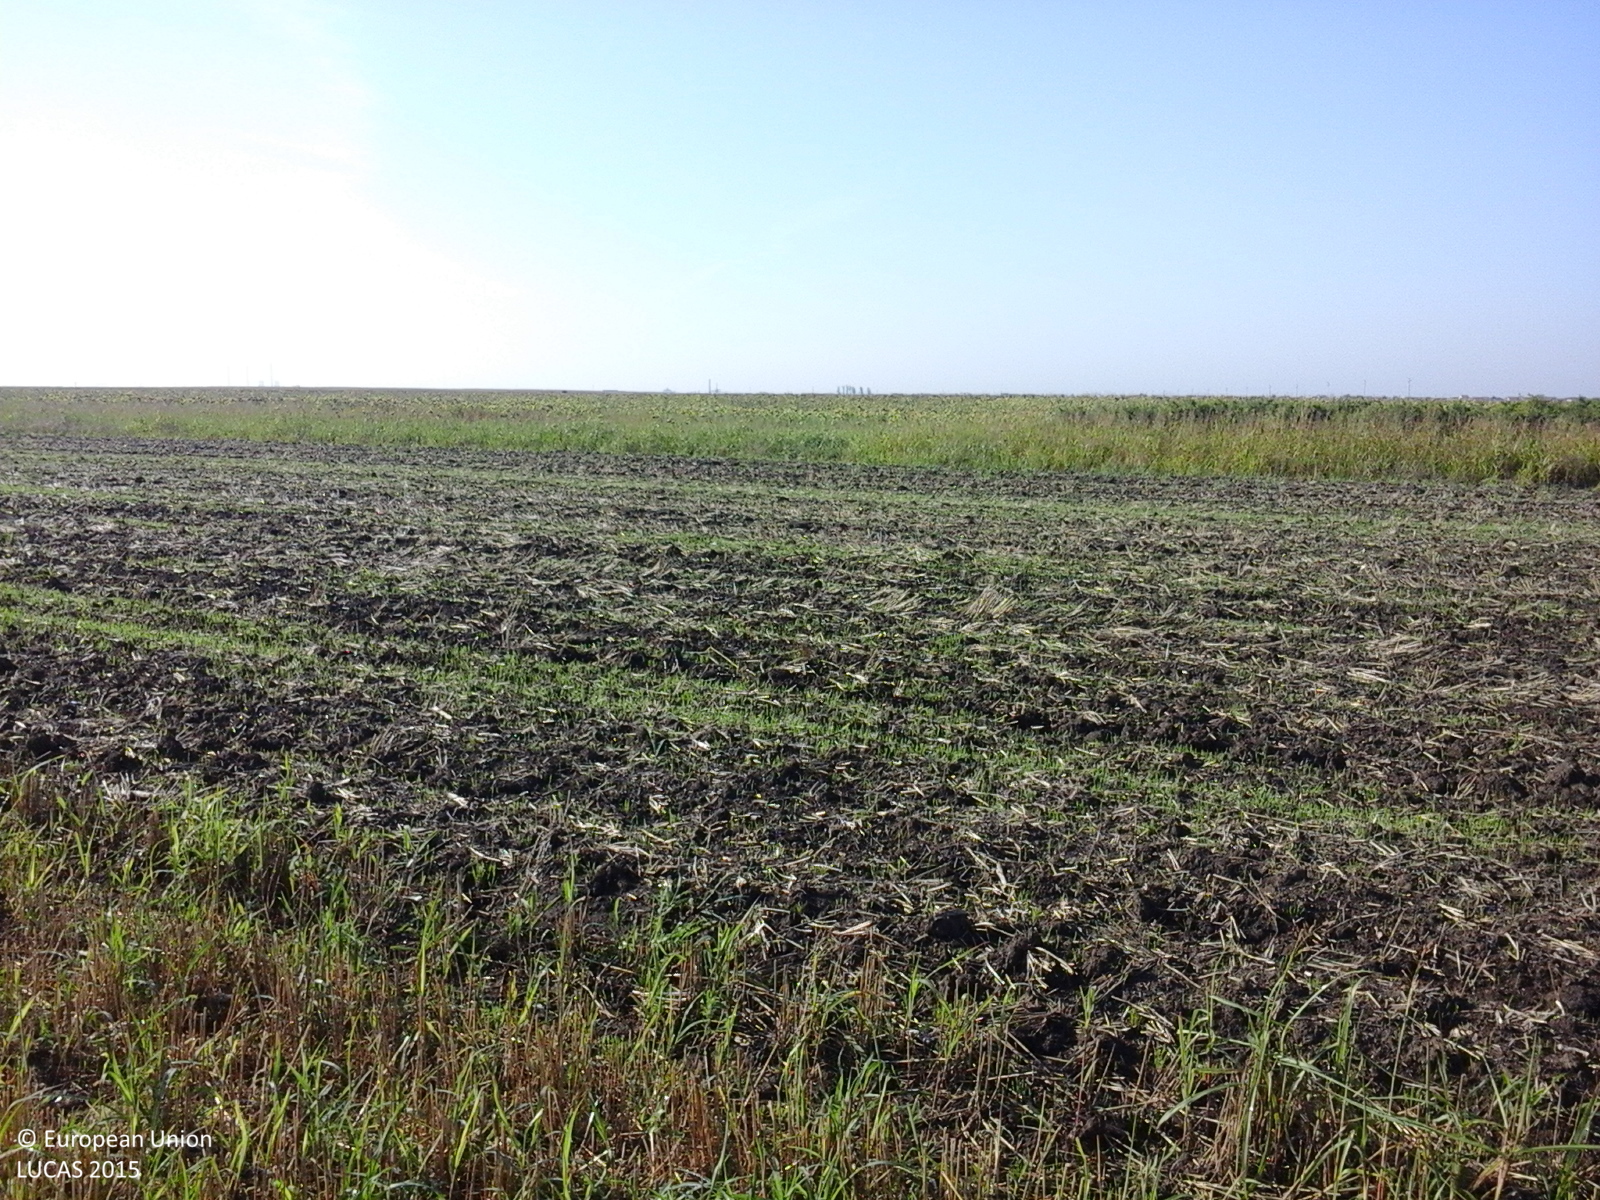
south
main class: Cropland
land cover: Durum wheat
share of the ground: 25 - 50 %
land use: Agriculture (excluding fallow land and kitchen gardens)
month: August
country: RO
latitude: 45.7865
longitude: 21.1305
